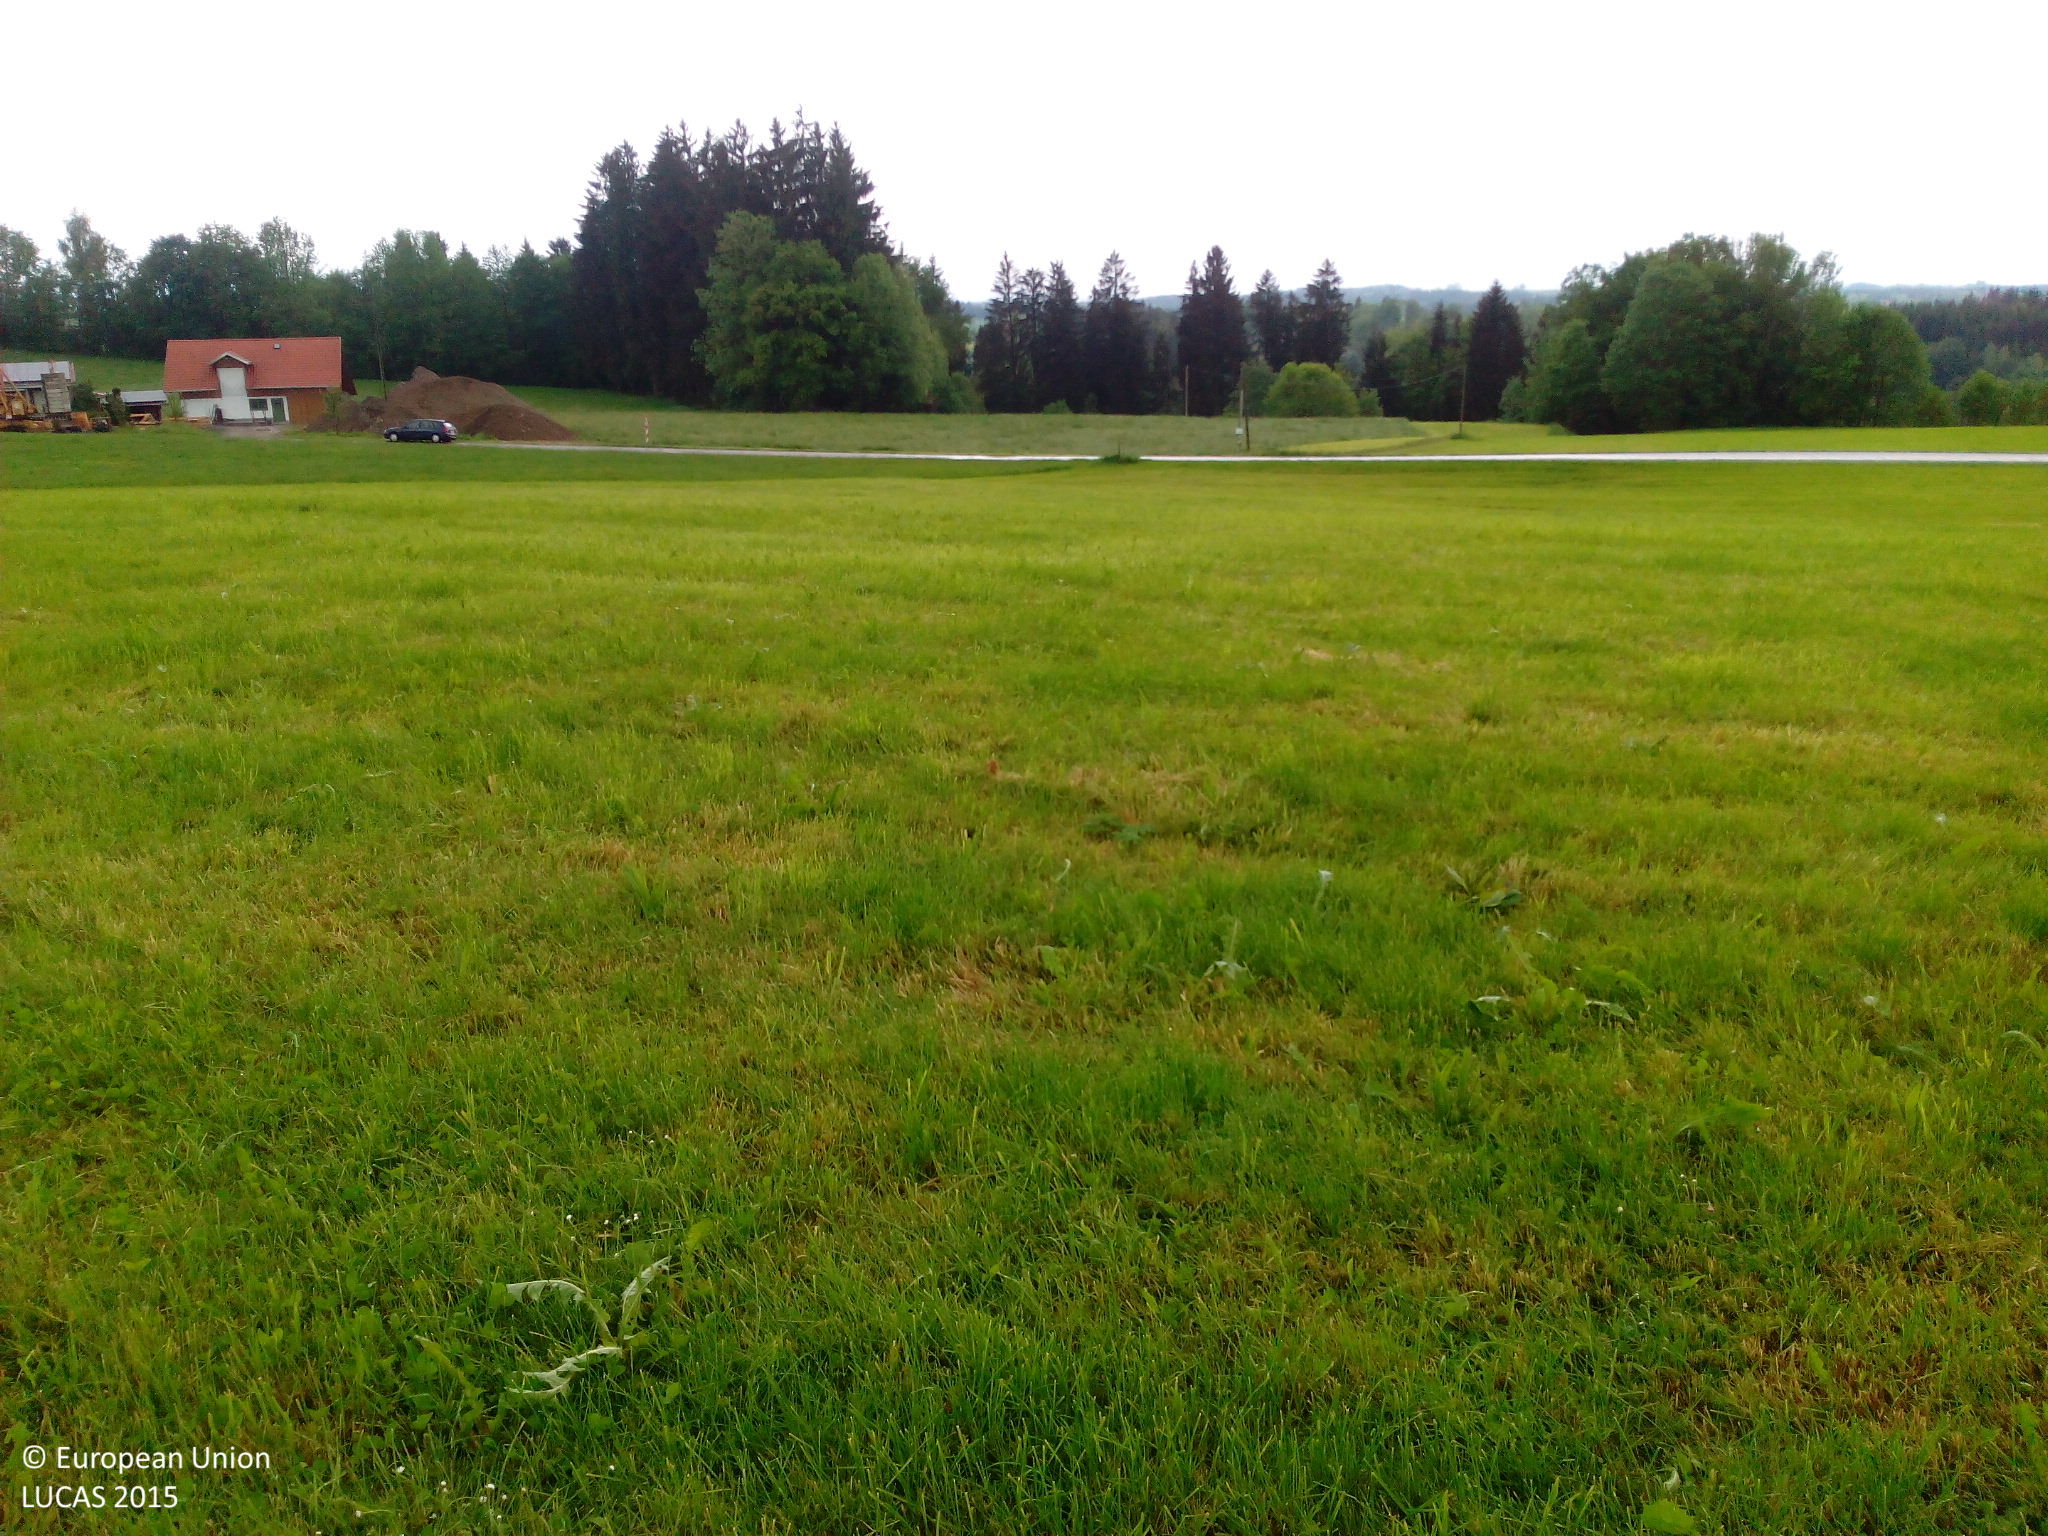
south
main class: Grassland
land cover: Grassland without tree/shrub cover
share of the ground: > 75 %
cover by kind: herbaceous plants 100 %
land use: Agriculture (excluding fallow land and kitchen gardens)
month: May
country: DE
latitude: 47.7556
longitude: 9.9334
